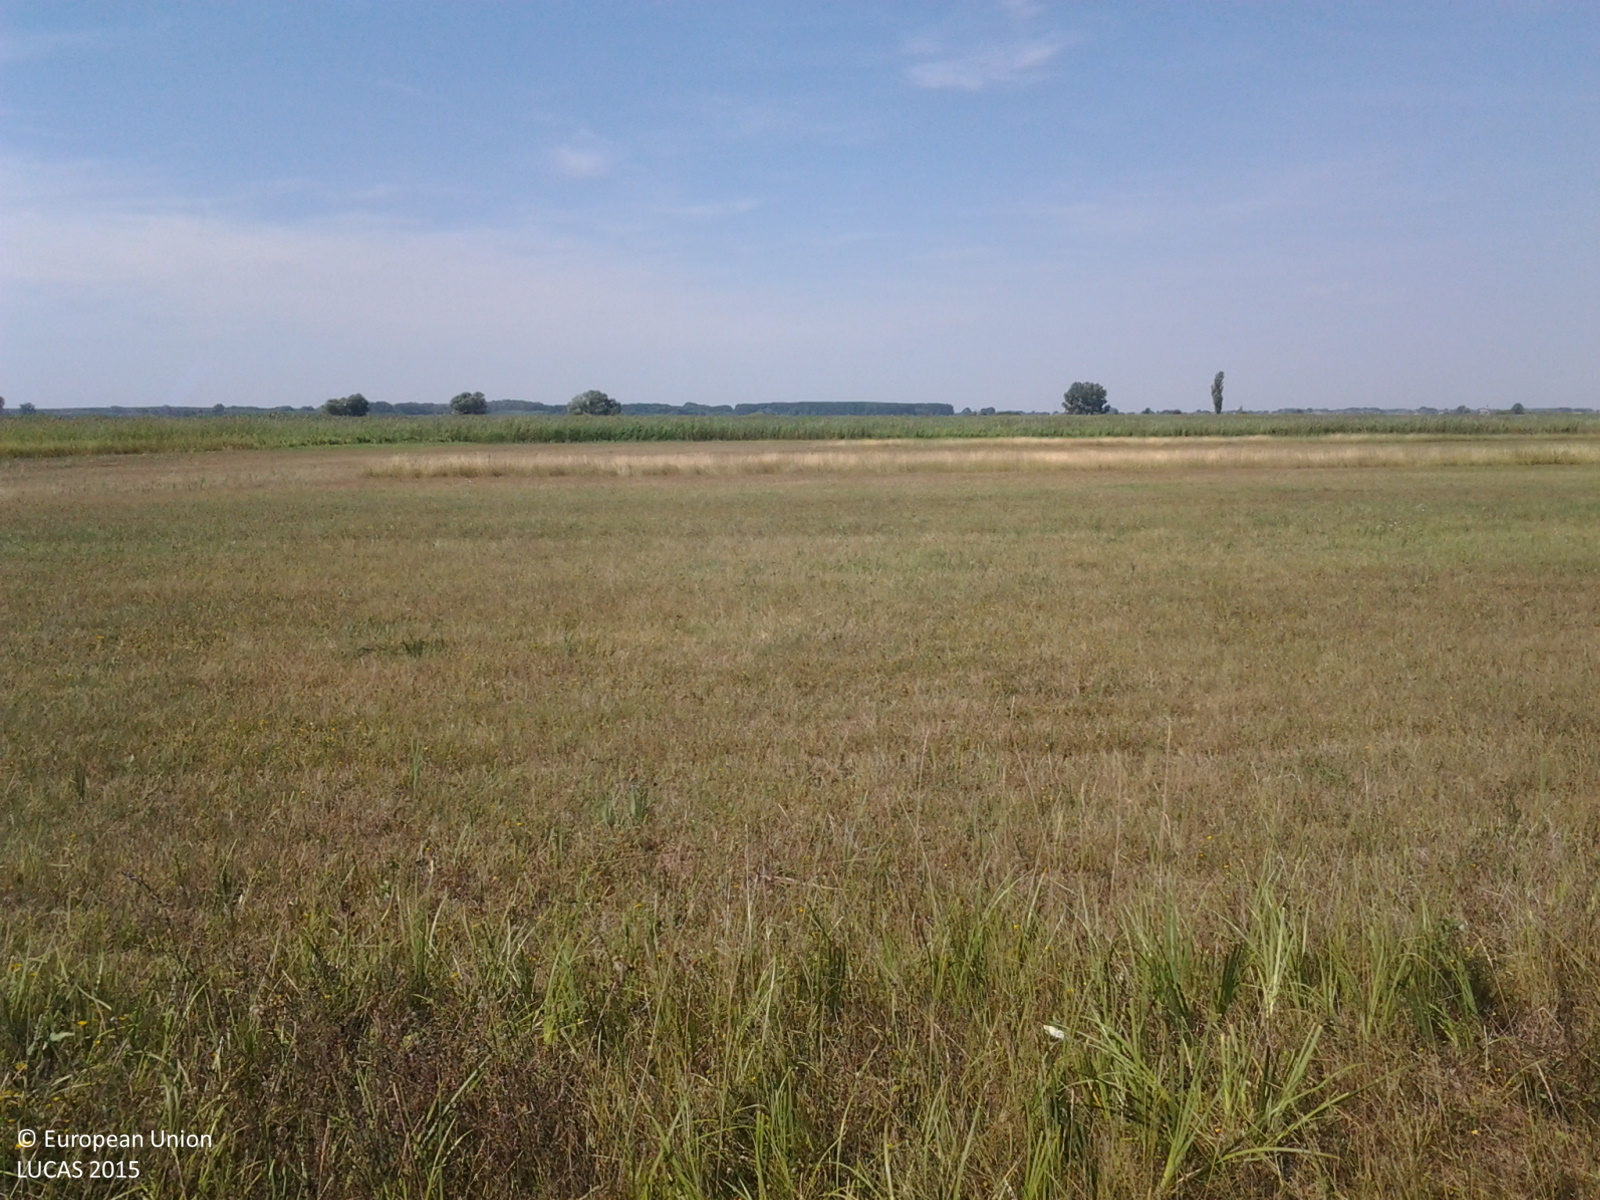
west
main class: Grassland
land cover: Grassland without tree/shrub cover
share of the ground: > 75 %
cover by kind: herbaceous plants 100 %
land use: Agriculture (excluding fallow land and kitchen gardens)
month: August
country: HU
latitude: 47.4038
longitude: 19.8164
